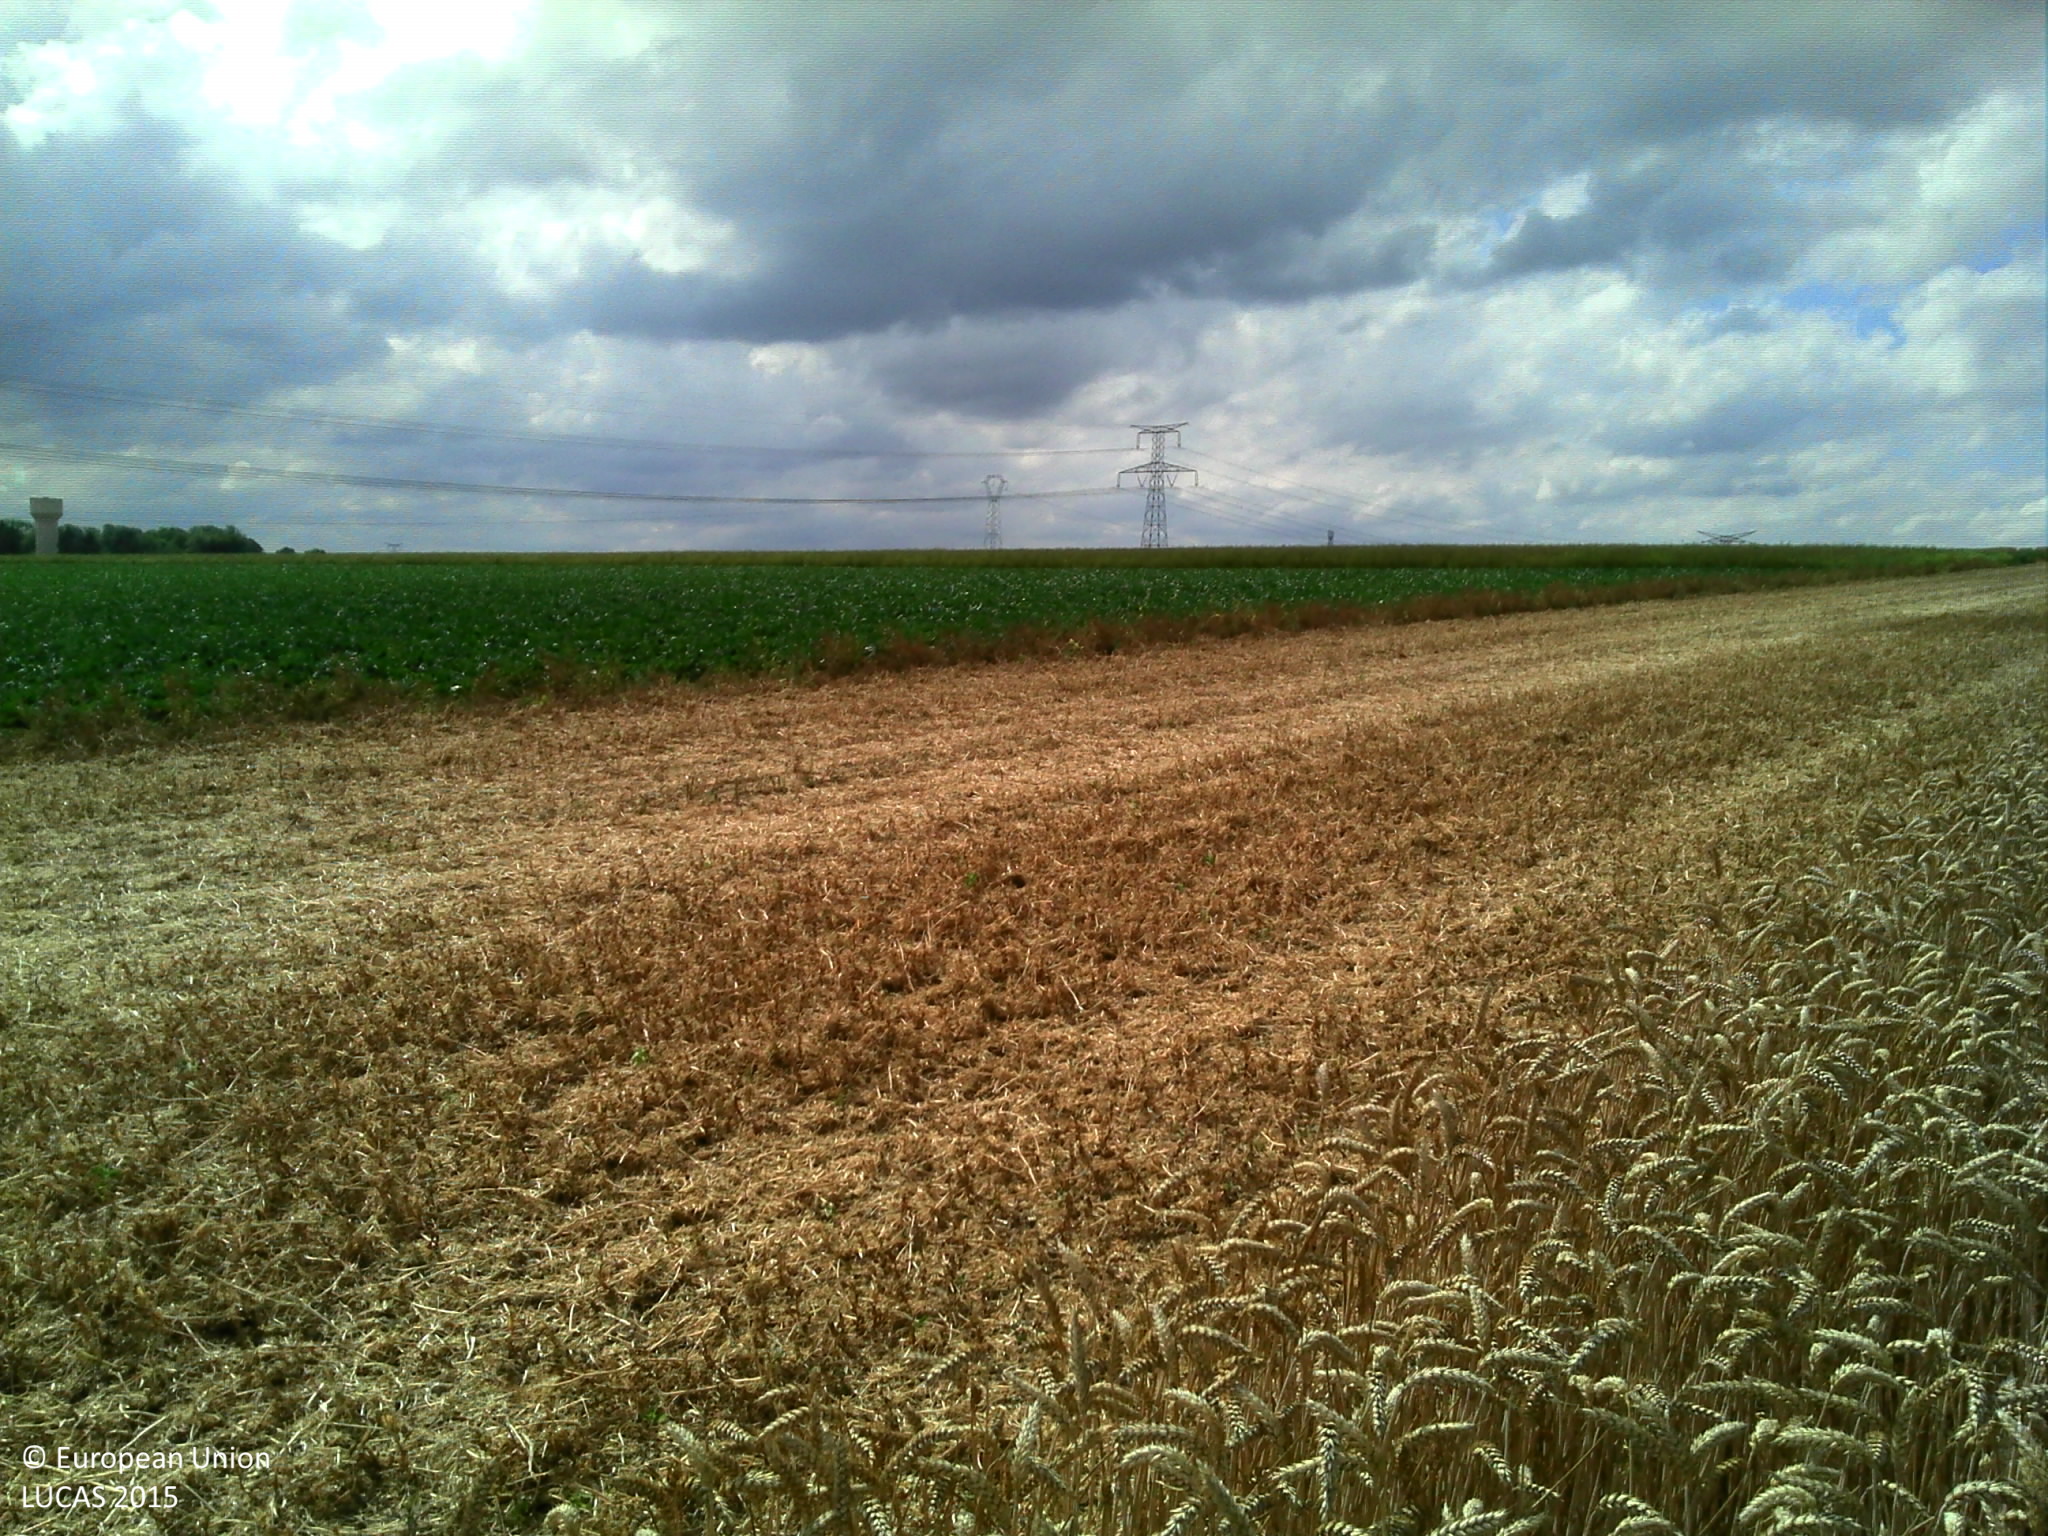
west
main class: Cropland
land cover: Common wheat
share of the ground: > 75 %
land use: Agriculture (excluding fallow land and kitchen gardens)
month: July
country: FR
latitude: 49.9724
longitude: 2.2197
